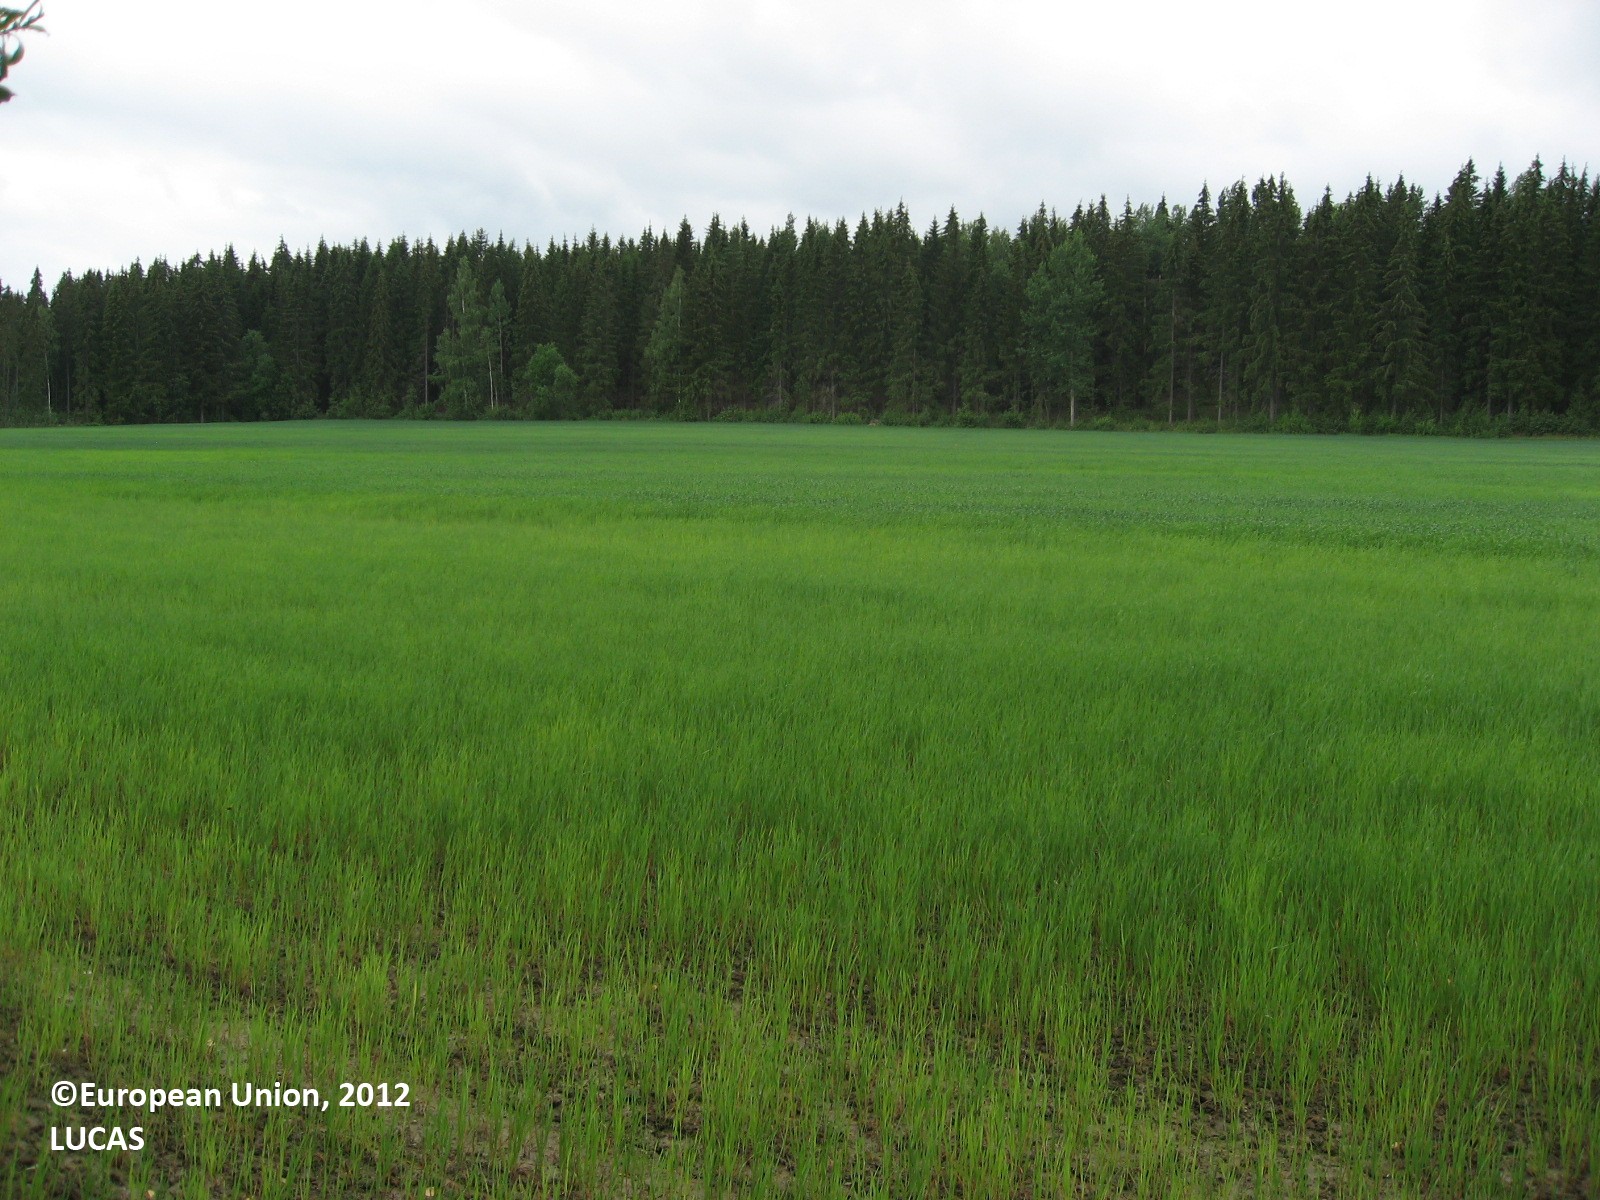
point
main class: Cropland
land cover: Oats
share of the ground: 50 - 75 %
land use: Agriculture (excluding fallow land and kitchen gardens)
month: July
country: FI
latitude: 60.8854
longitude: 25.6245
